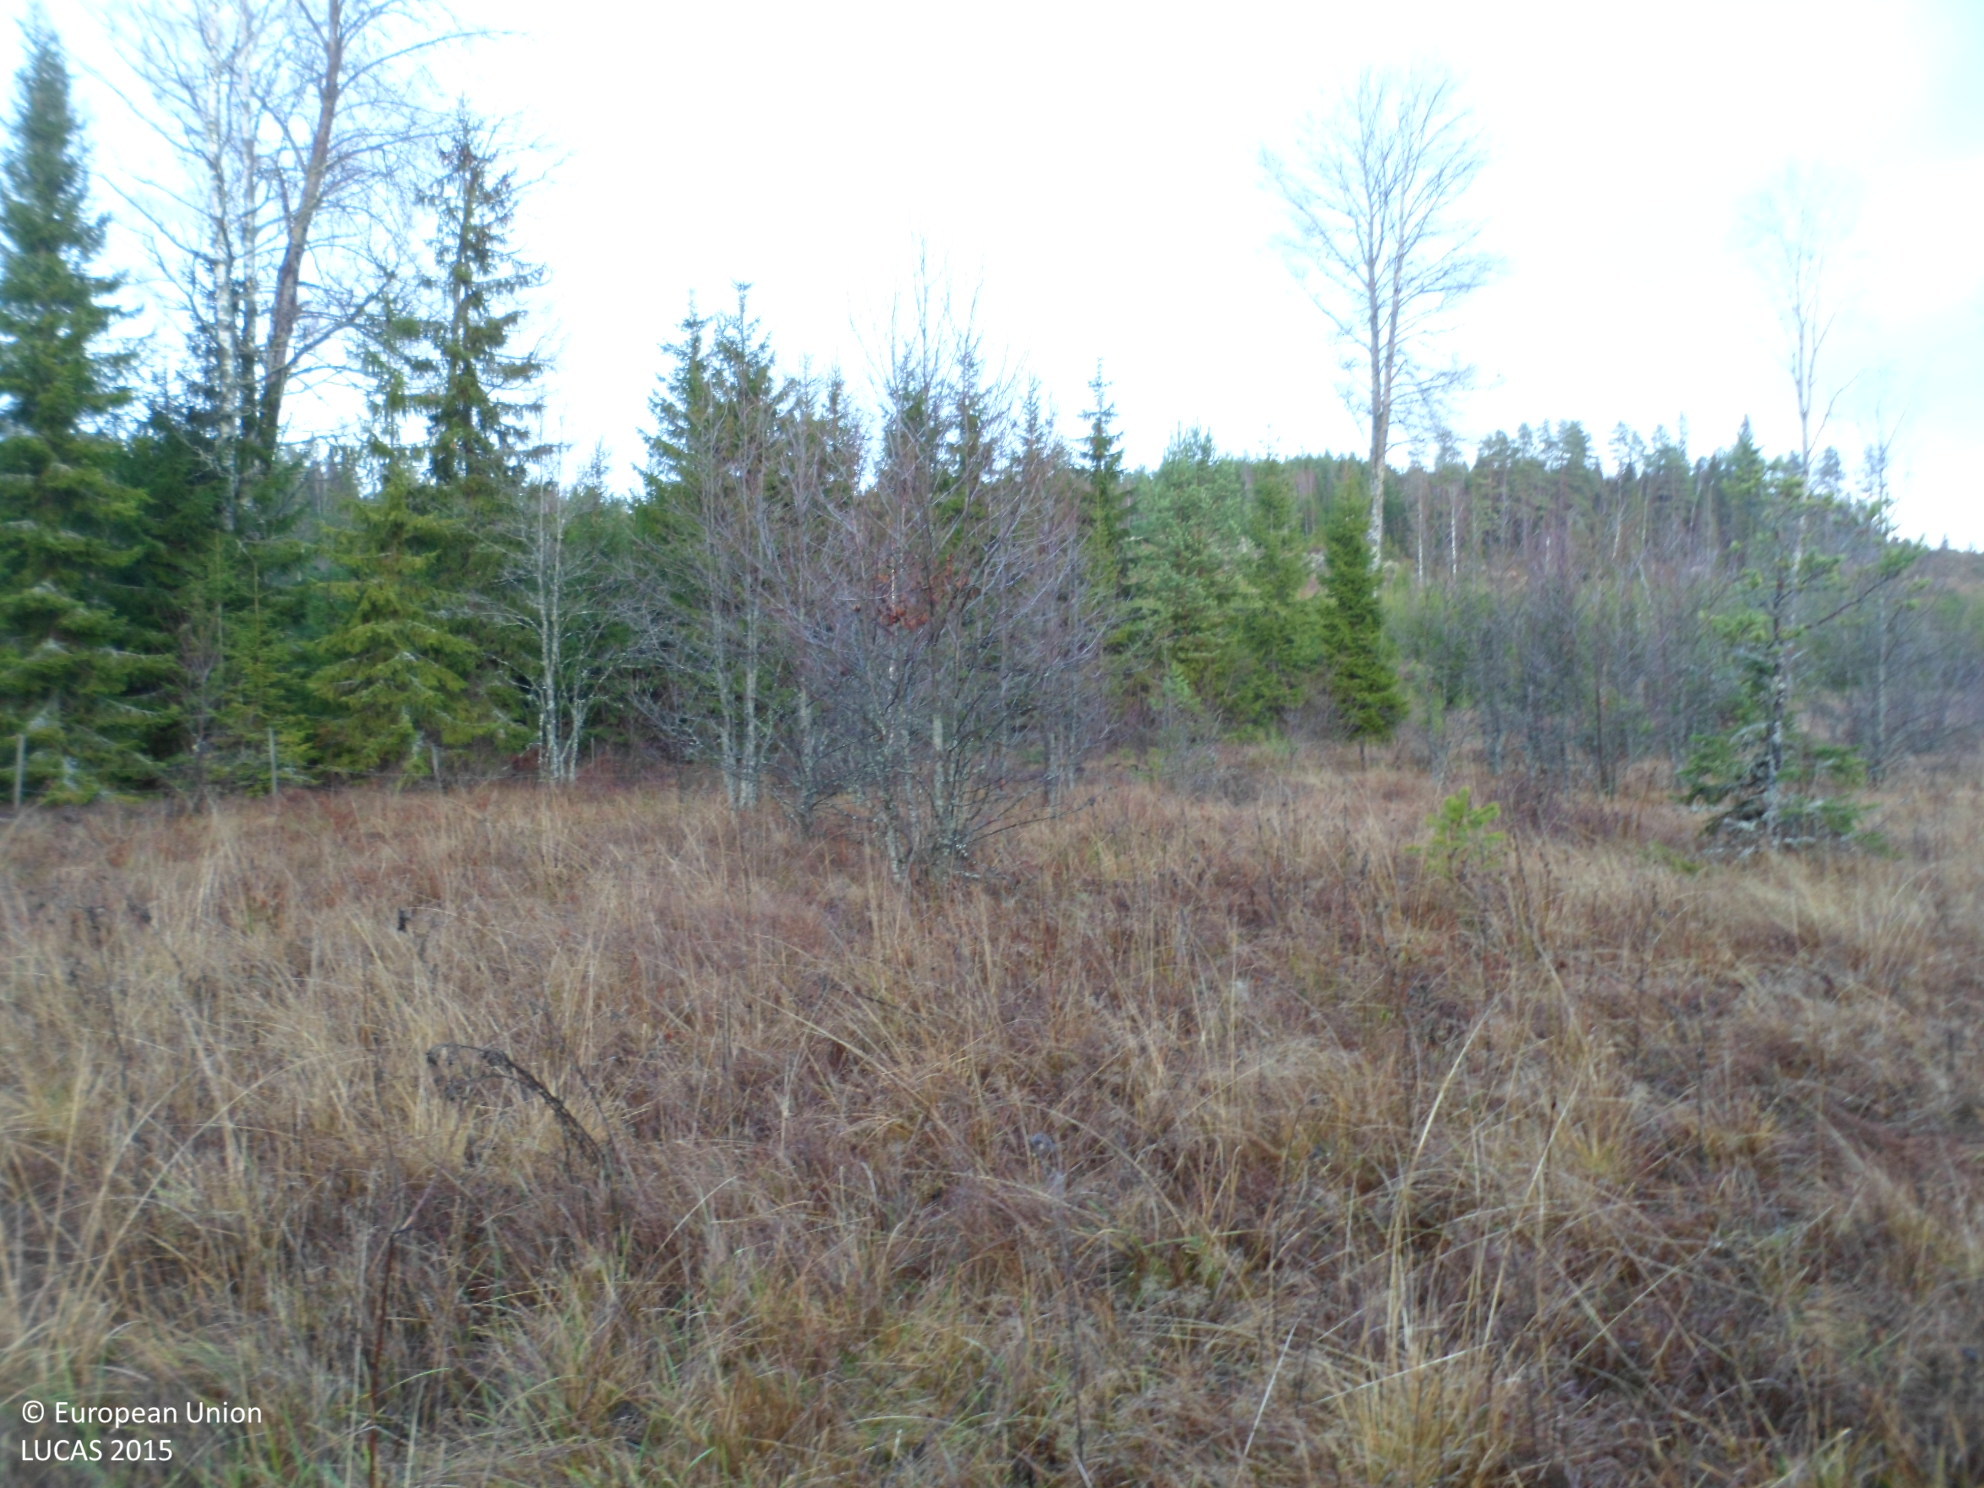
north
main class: Grassland
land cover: Grassland without tree/shrub cover
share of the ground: > 75 %
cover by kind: herbaceous plants 90 %, lichens and mosses 10 %
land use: Agriculture (excluding fallow land and kitchen gardens)
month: November
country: SE
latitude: 57.5461
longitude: 15.9625
